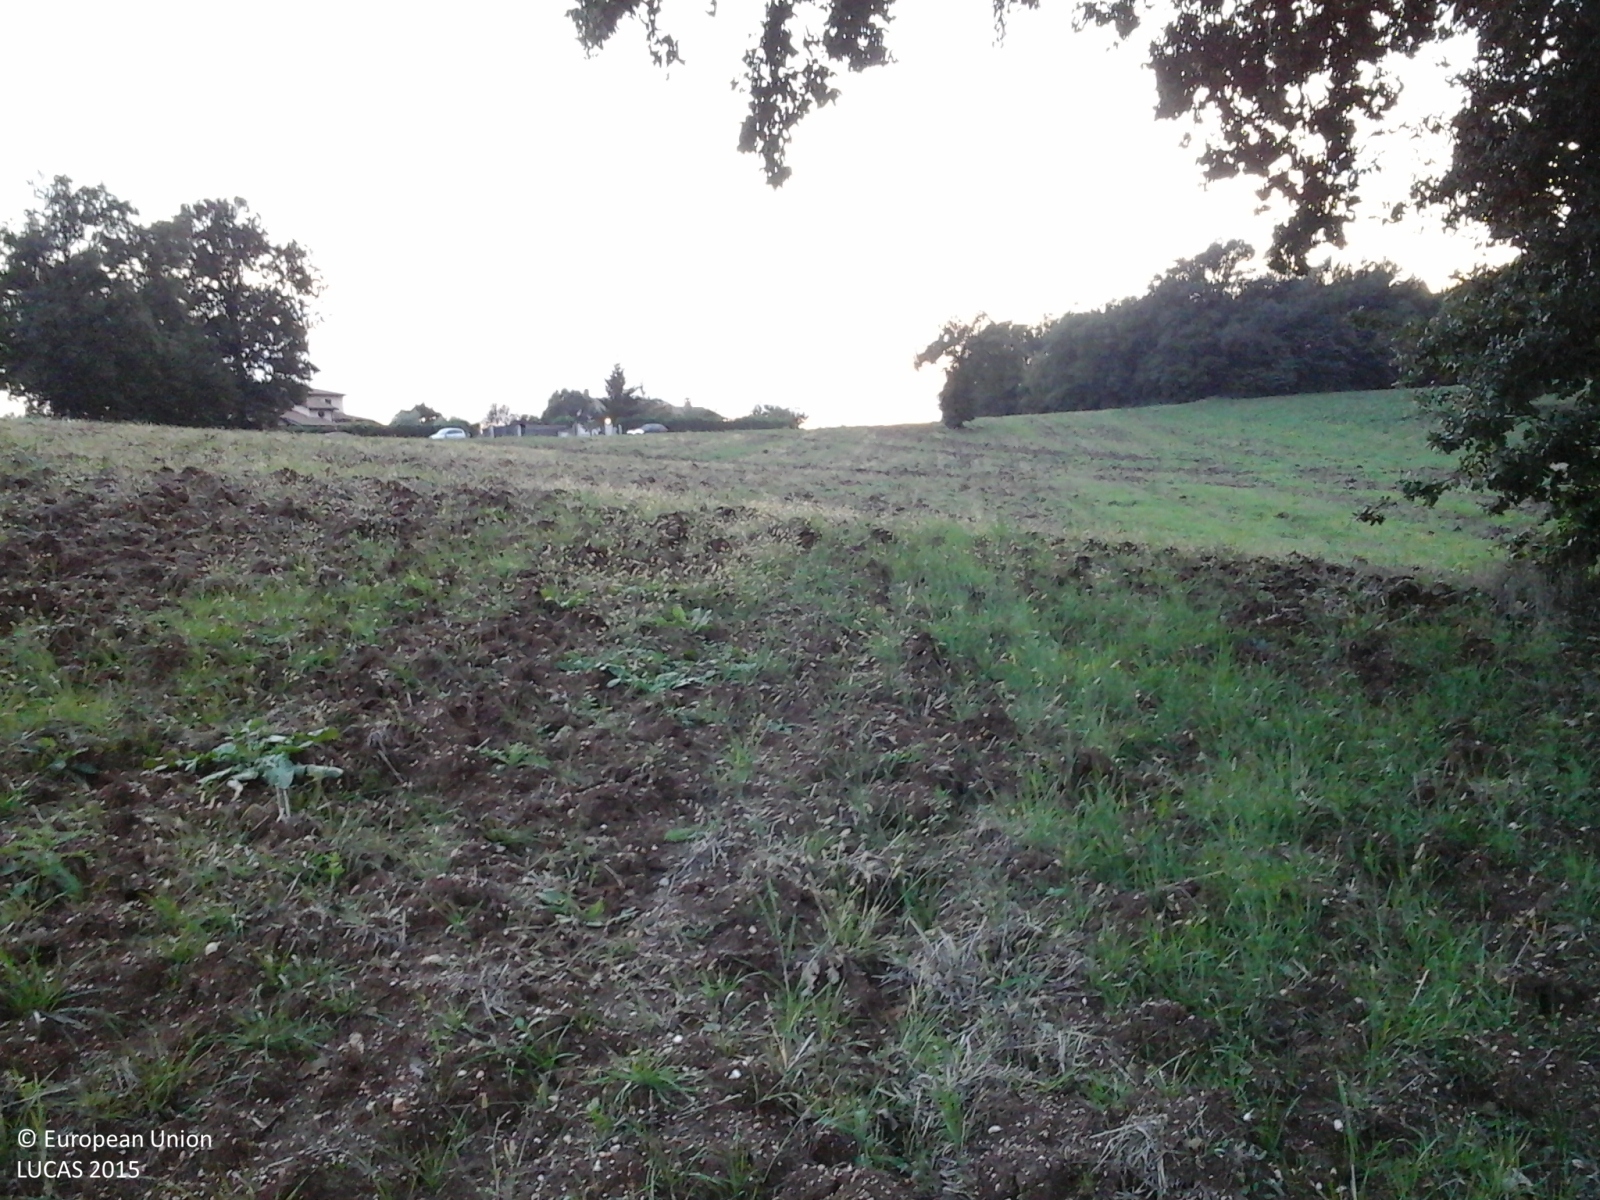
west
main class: Cropland
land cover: Common wheat
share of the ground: < 10 %
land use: Agriculture (excluding fallow land and kitchen gardens)
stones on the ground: < 10 %
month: October
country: IT
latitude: 42.6763
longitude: 12.5424
